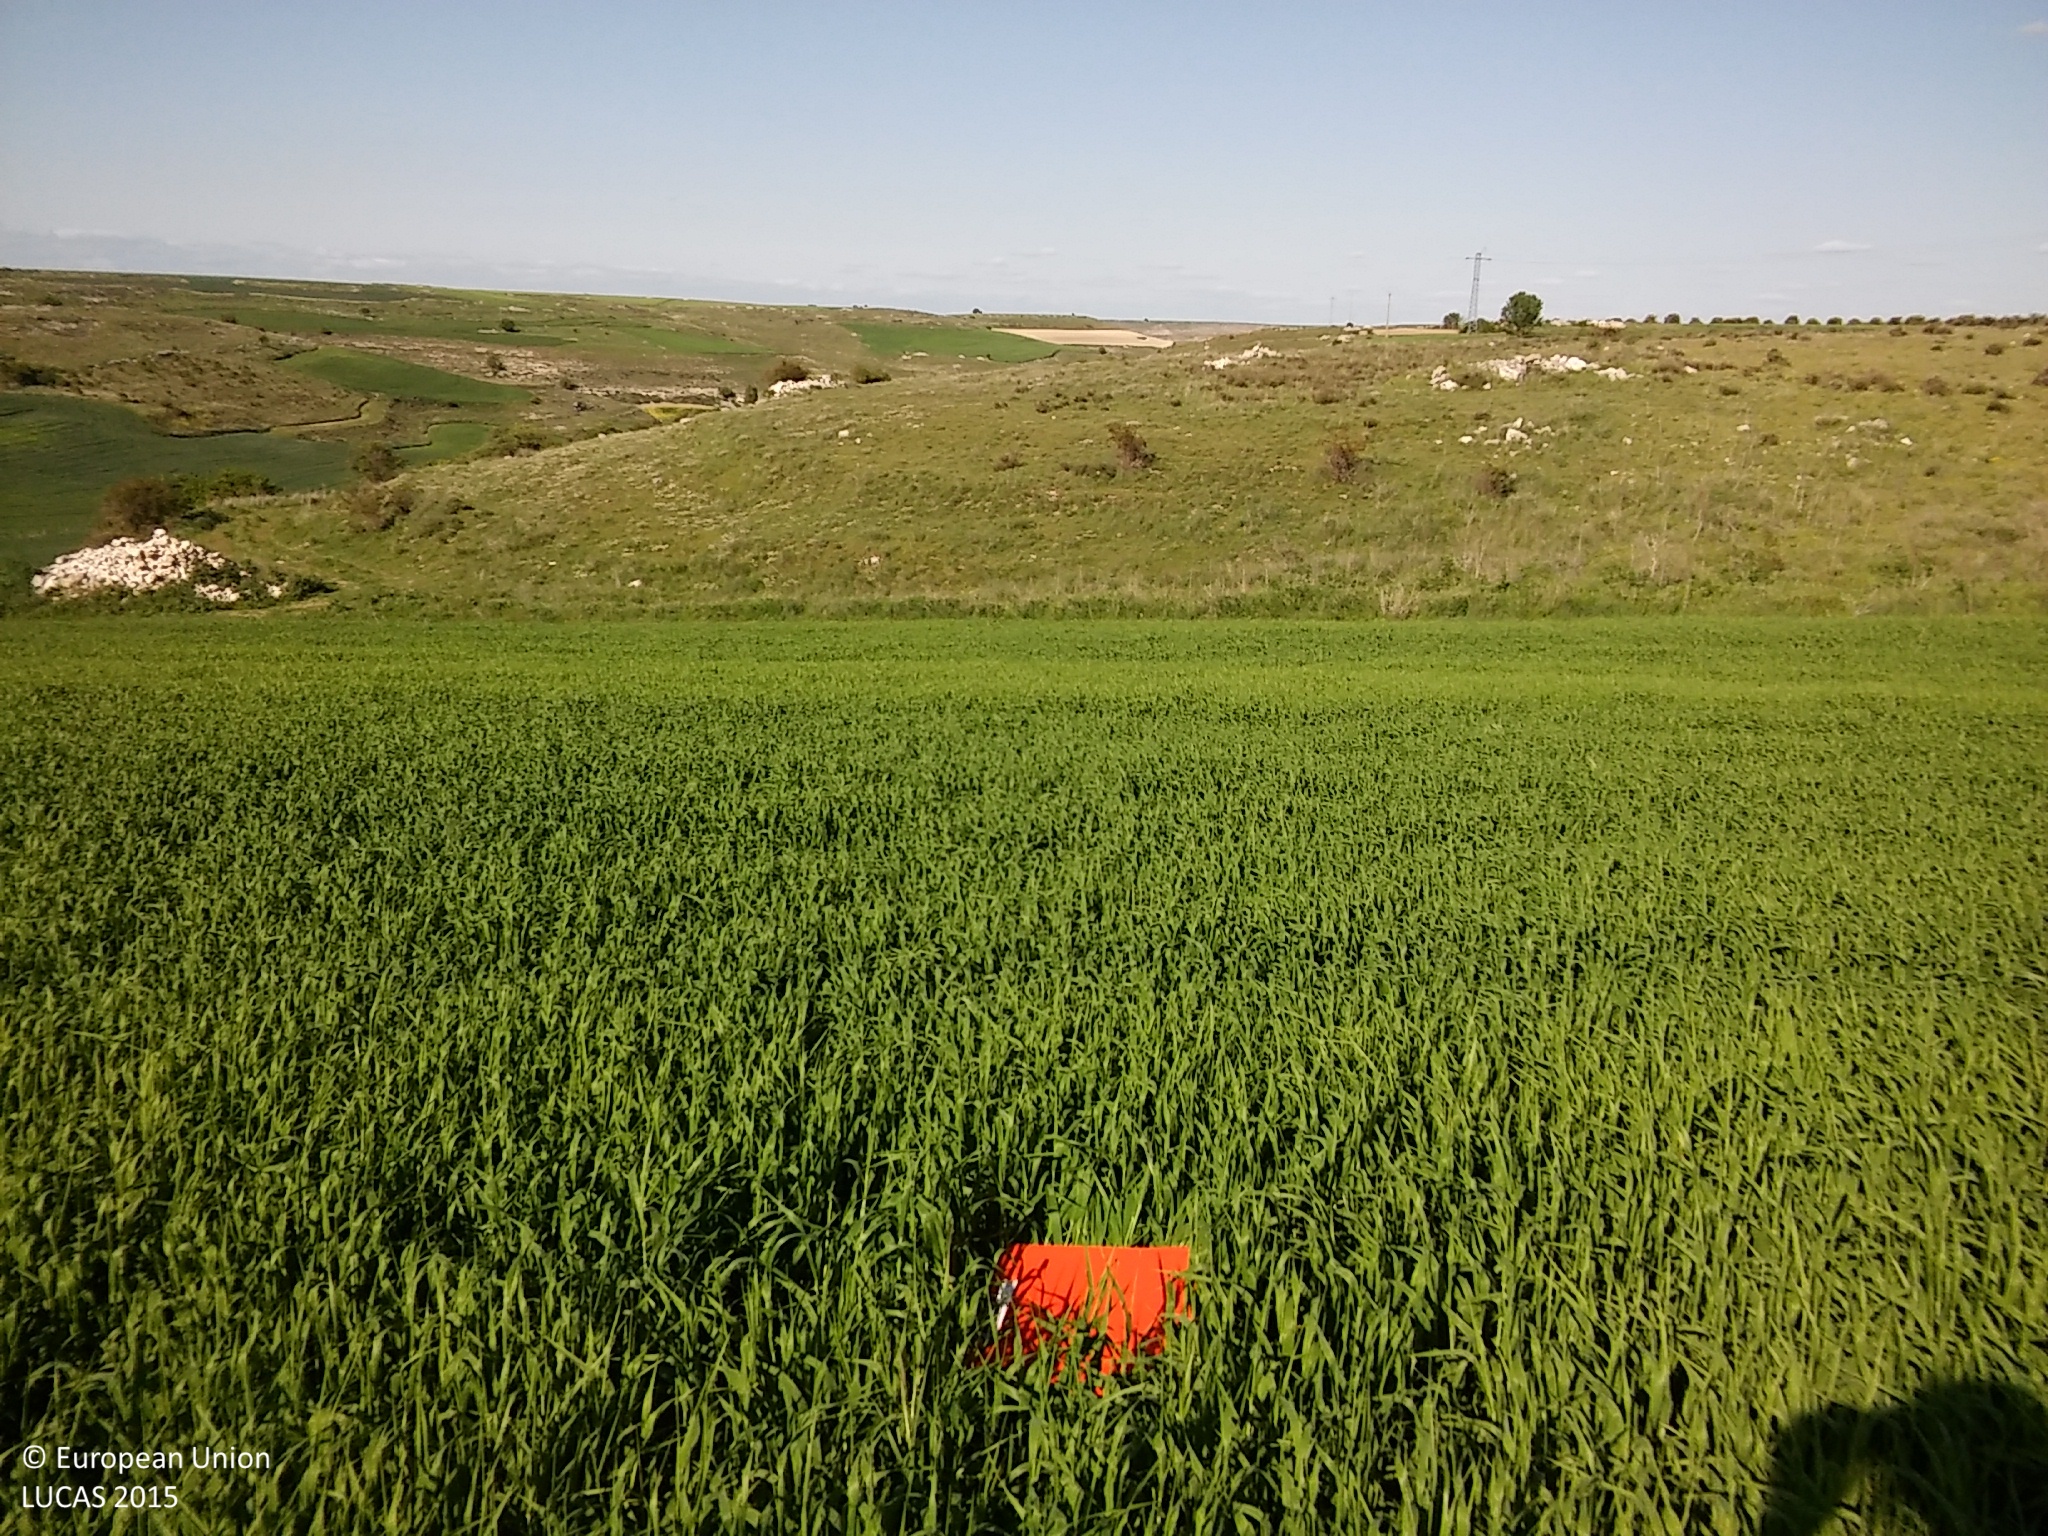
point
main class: Cropland
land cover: Barley
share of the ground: > 75 %
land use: Agriculture (excluding fallow land and kitchen gardens)
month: May
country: ES
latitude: 41.4641
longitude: -4.0763
